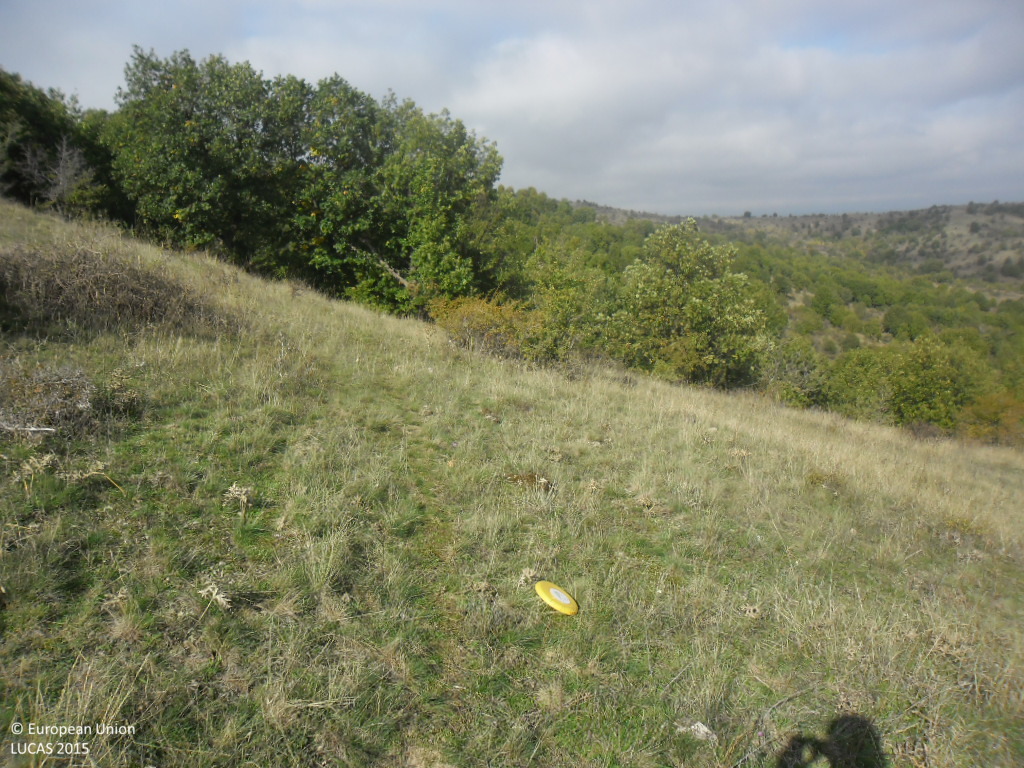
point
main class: Grassland
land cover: Grassland without tree/shrub cover
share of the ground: > 75 %
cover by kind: herbaceous plants 100 %
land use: Agriculture (excluding fallow land and kitchen gardens)
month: October
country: BG
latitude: 41.9323
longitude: 23.0598
